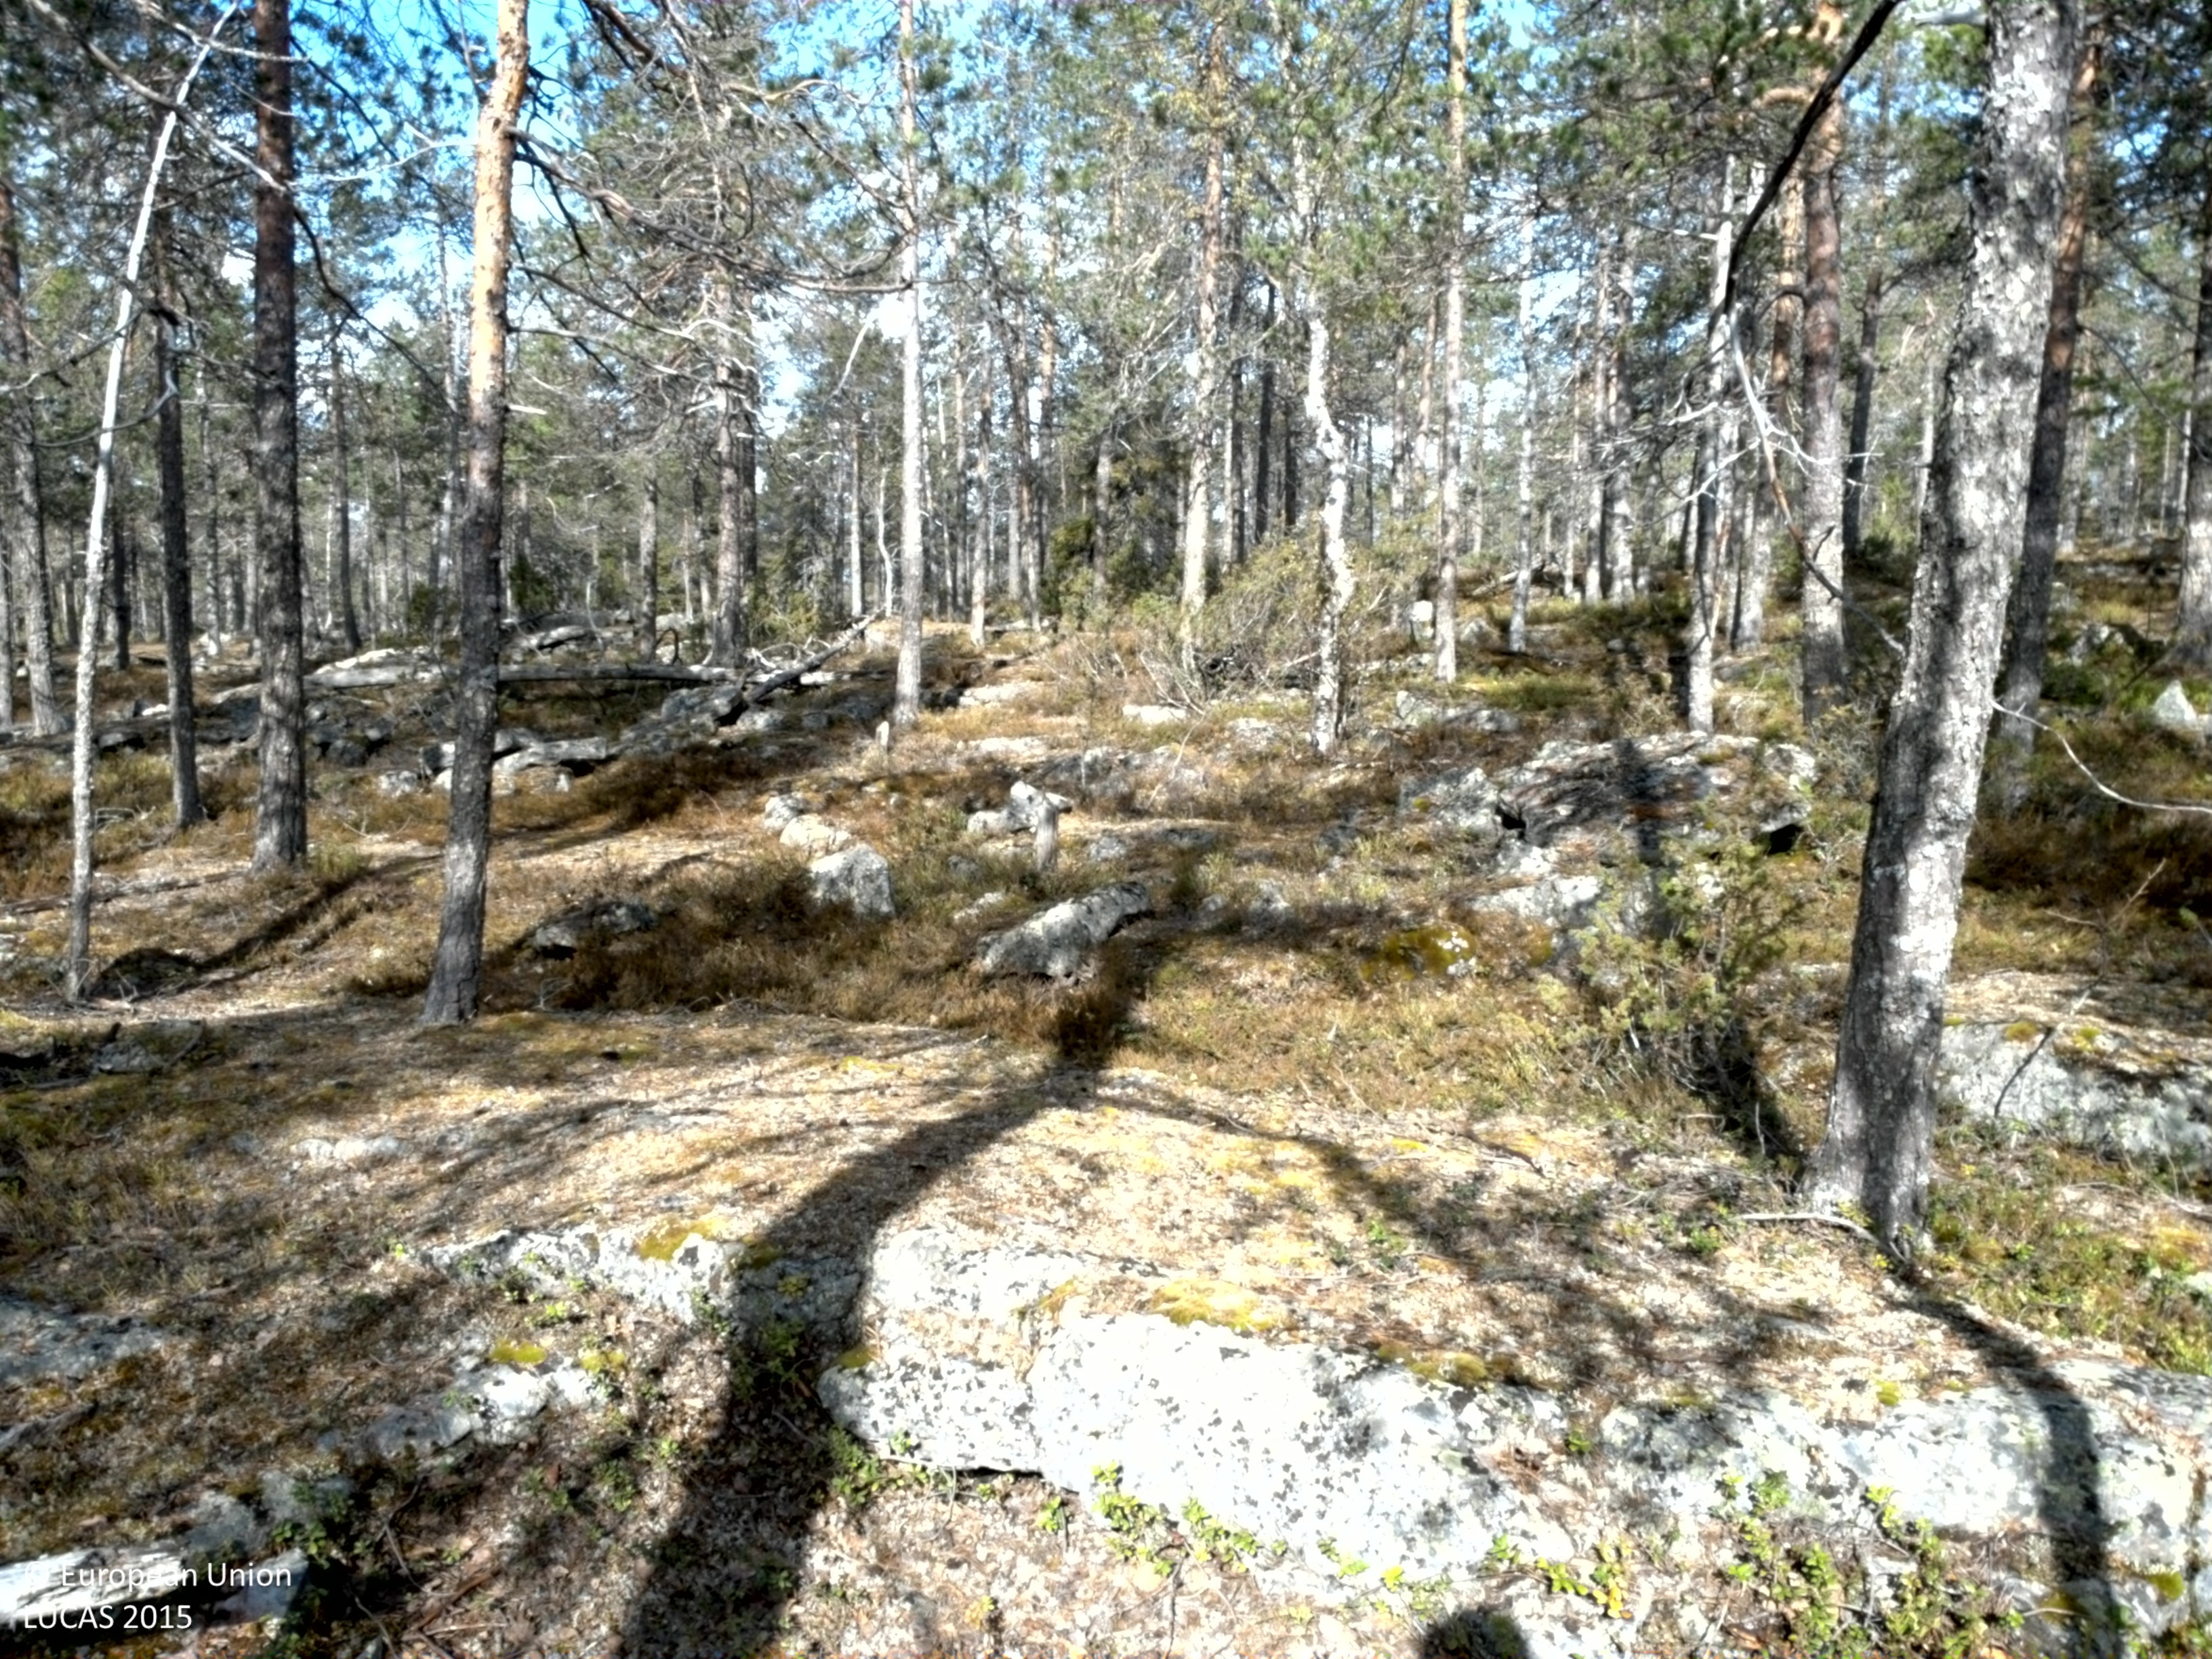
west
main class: Woodland
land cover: Pine dominated coniferous woodland
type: boreal forest
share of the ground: 25 - 50 %
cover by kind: shrubs 45 %, coniferous forest trees 35 %, lichens and mosses 10 %, consolidated bare surface 10 %
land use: Forestry
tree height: > 5 m
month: June
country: SE
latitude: 66.4100
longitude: 23.5337
